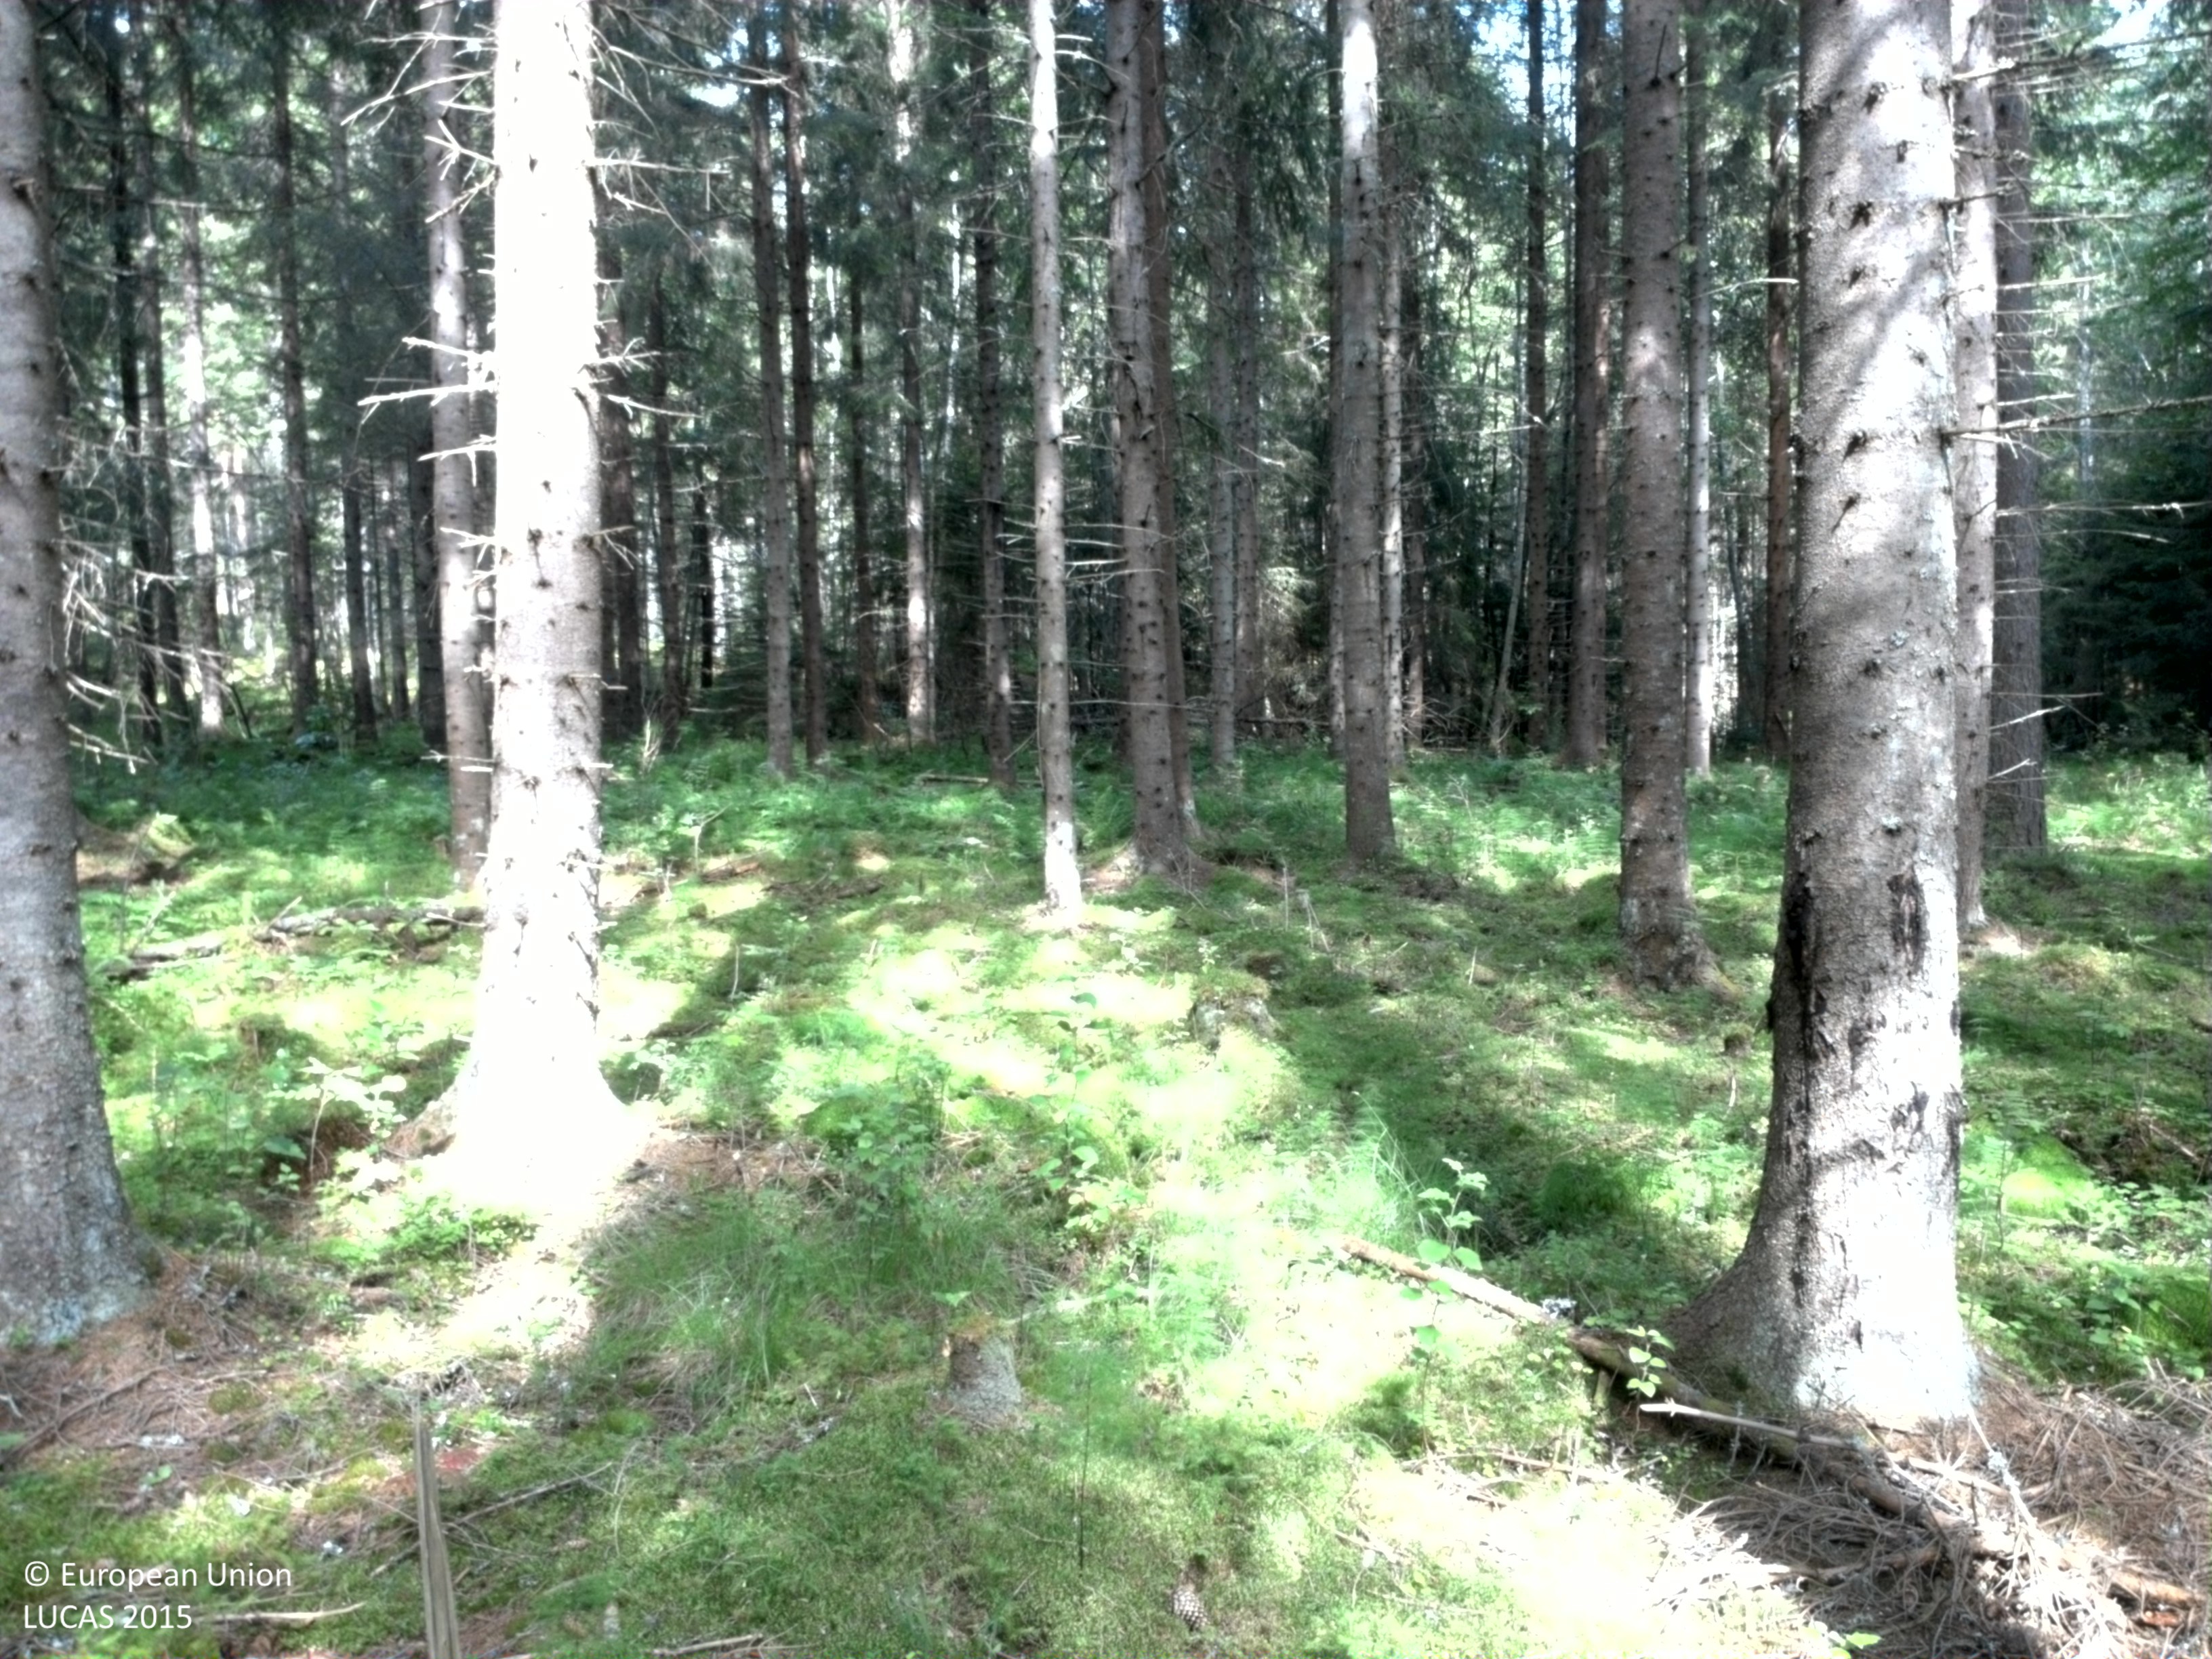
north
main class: Woodland
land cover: Spruce dominated coniferous woodland
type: boreal forest
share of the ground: 50 - 75 %
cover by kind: coniferous forest trees 65 %, shrubs 15 %, lichens and mosses 10 %, broadleaved forest trees 5 %, herbaceous plants 5 %
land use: Forestry
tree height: > 5 m
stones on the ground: < 10 %
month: August
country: SE
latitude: 60.0123
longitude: 13.4527
